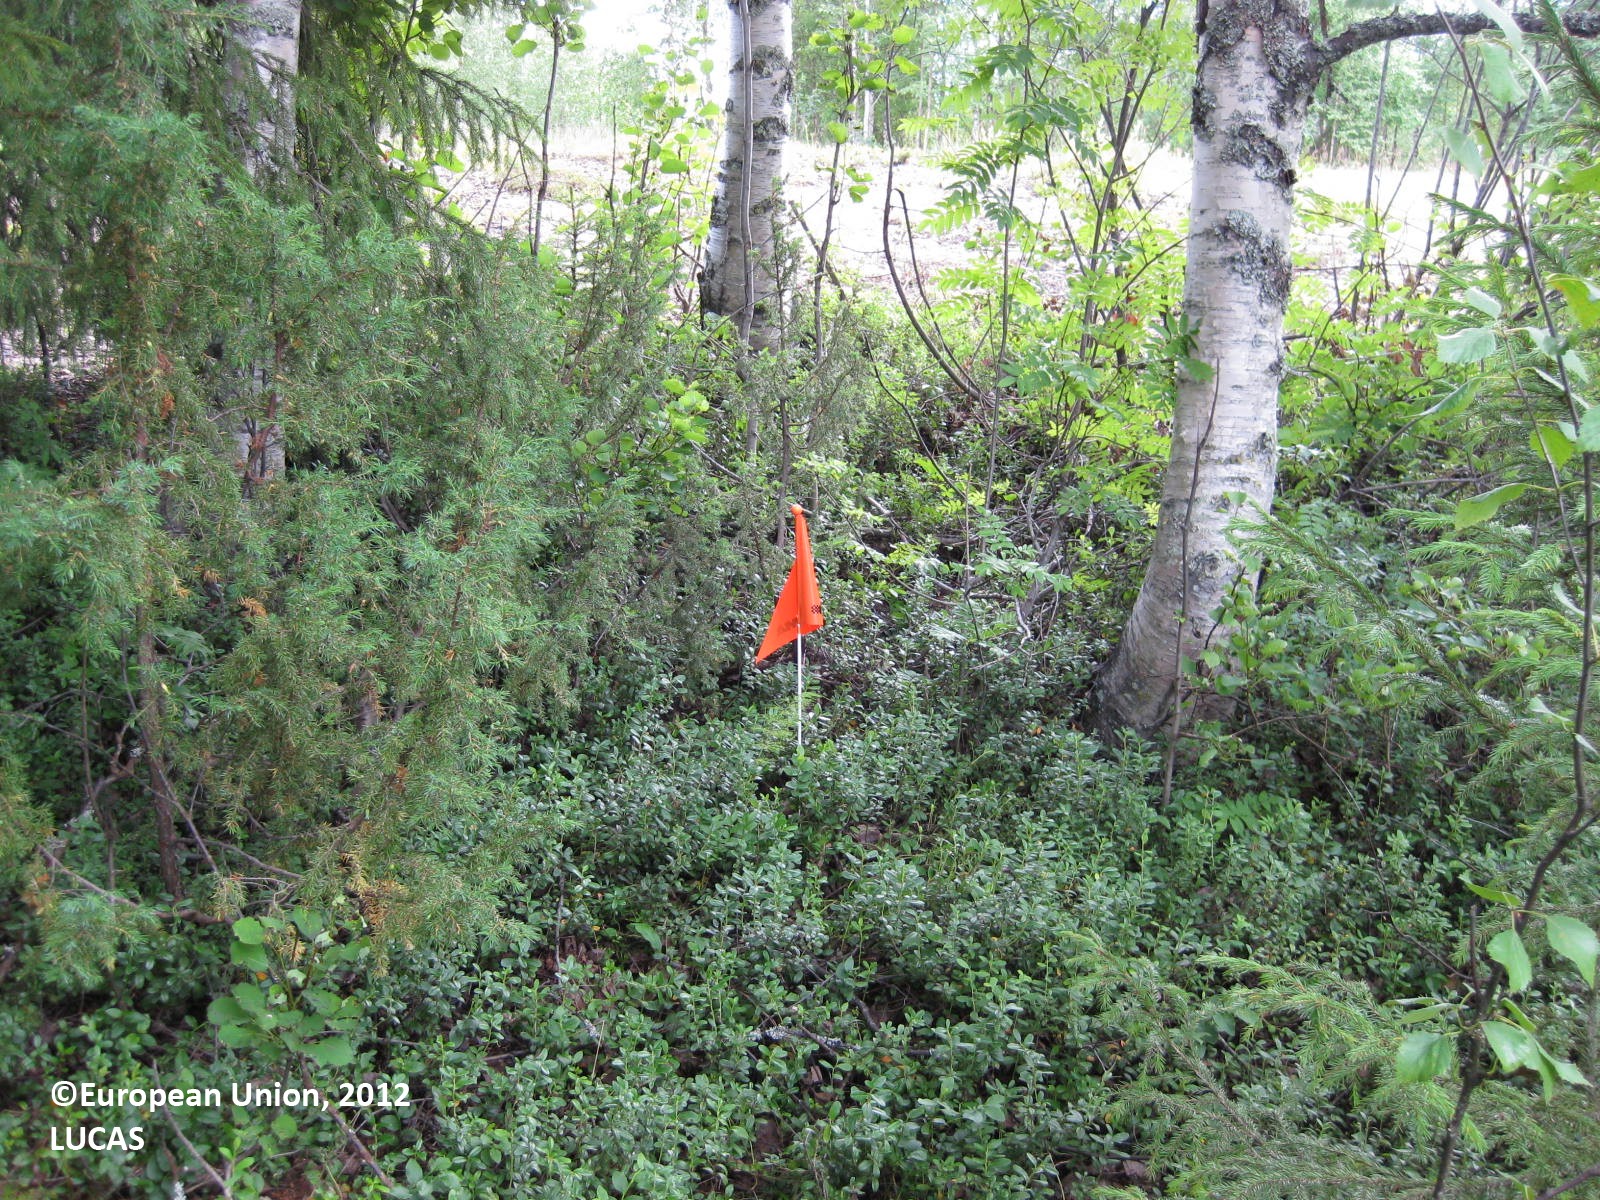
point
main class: Woodland
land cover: Spruce dominated mixed woodland
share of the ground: > 75 %
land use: Residential
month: July
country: FI
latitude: 65.7034
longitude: 28.5203
